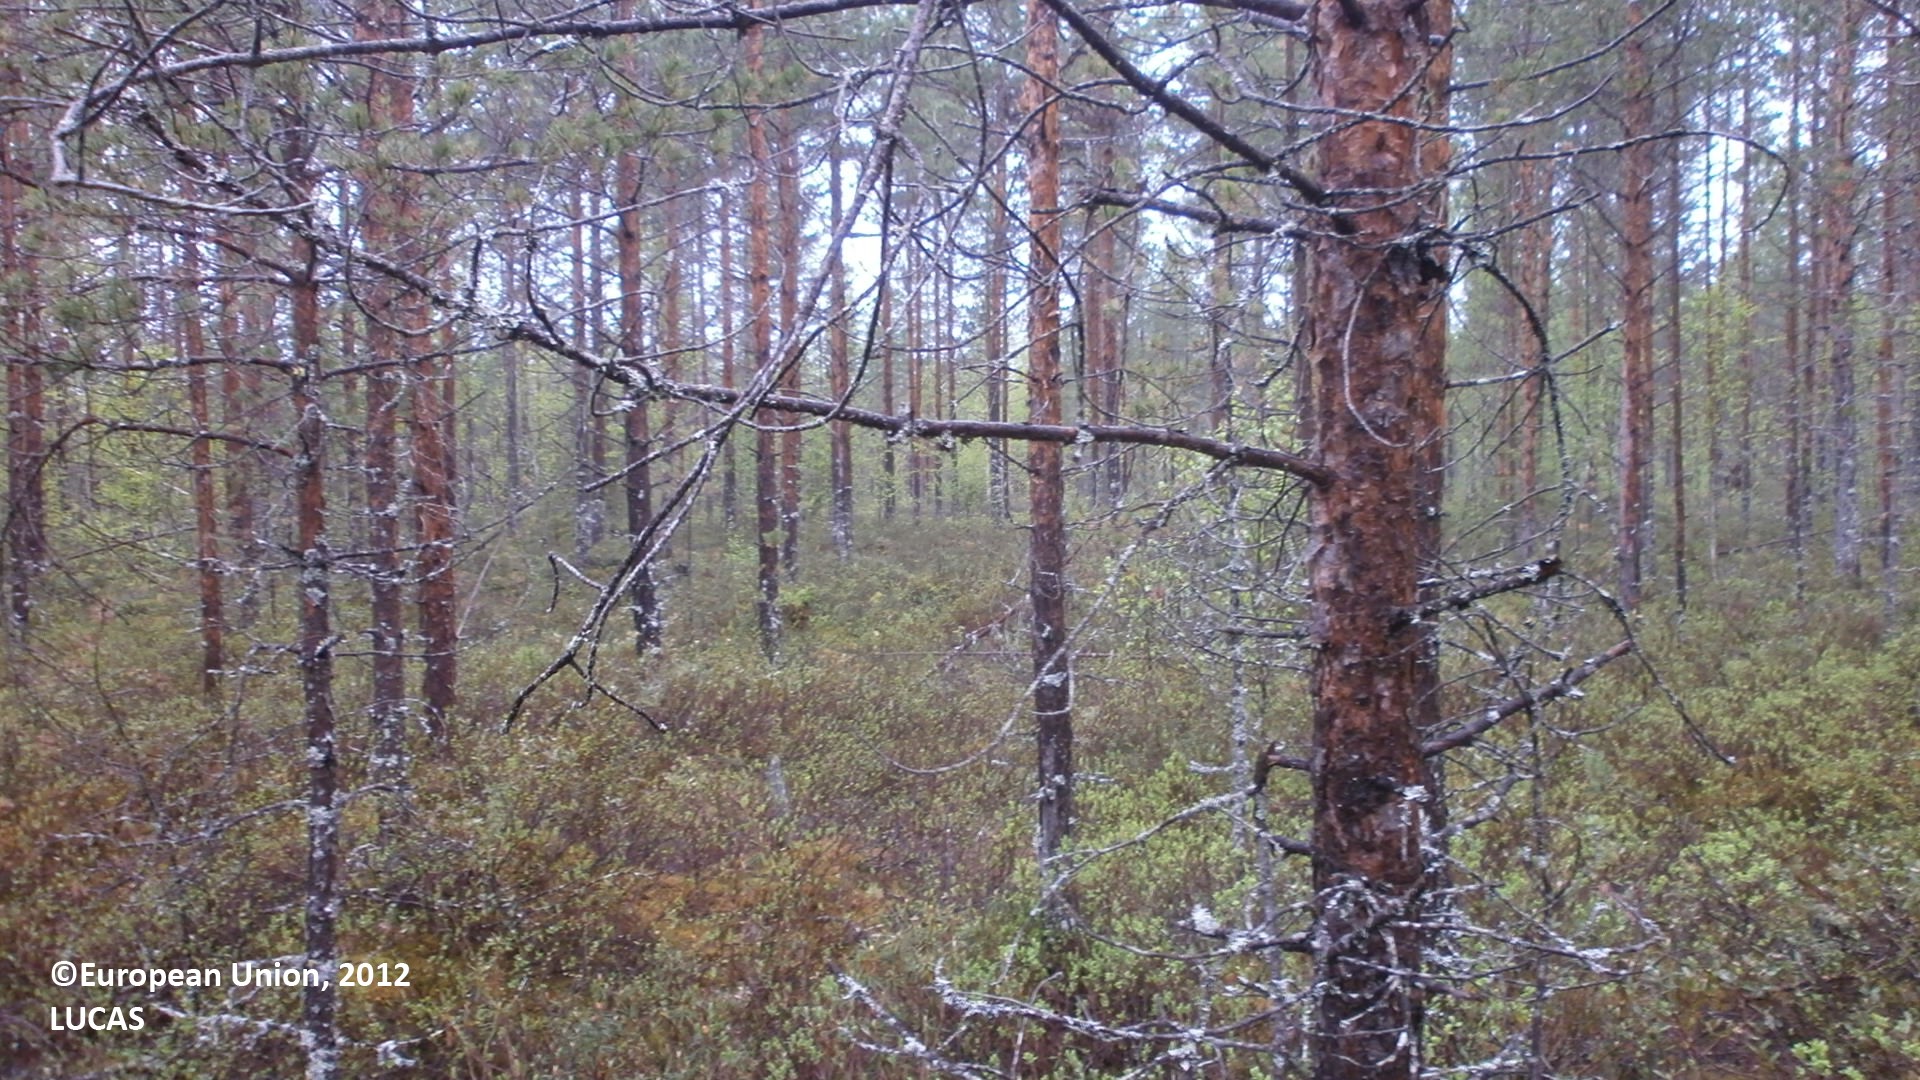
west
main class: Woodland
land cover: Pine dominated coniferous woodland
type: mire and swamp forests
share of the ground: 50 - 75 %
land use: Forestry
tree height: > 5 m
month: June
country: FI
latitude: 64.0877
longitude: 26.0863
